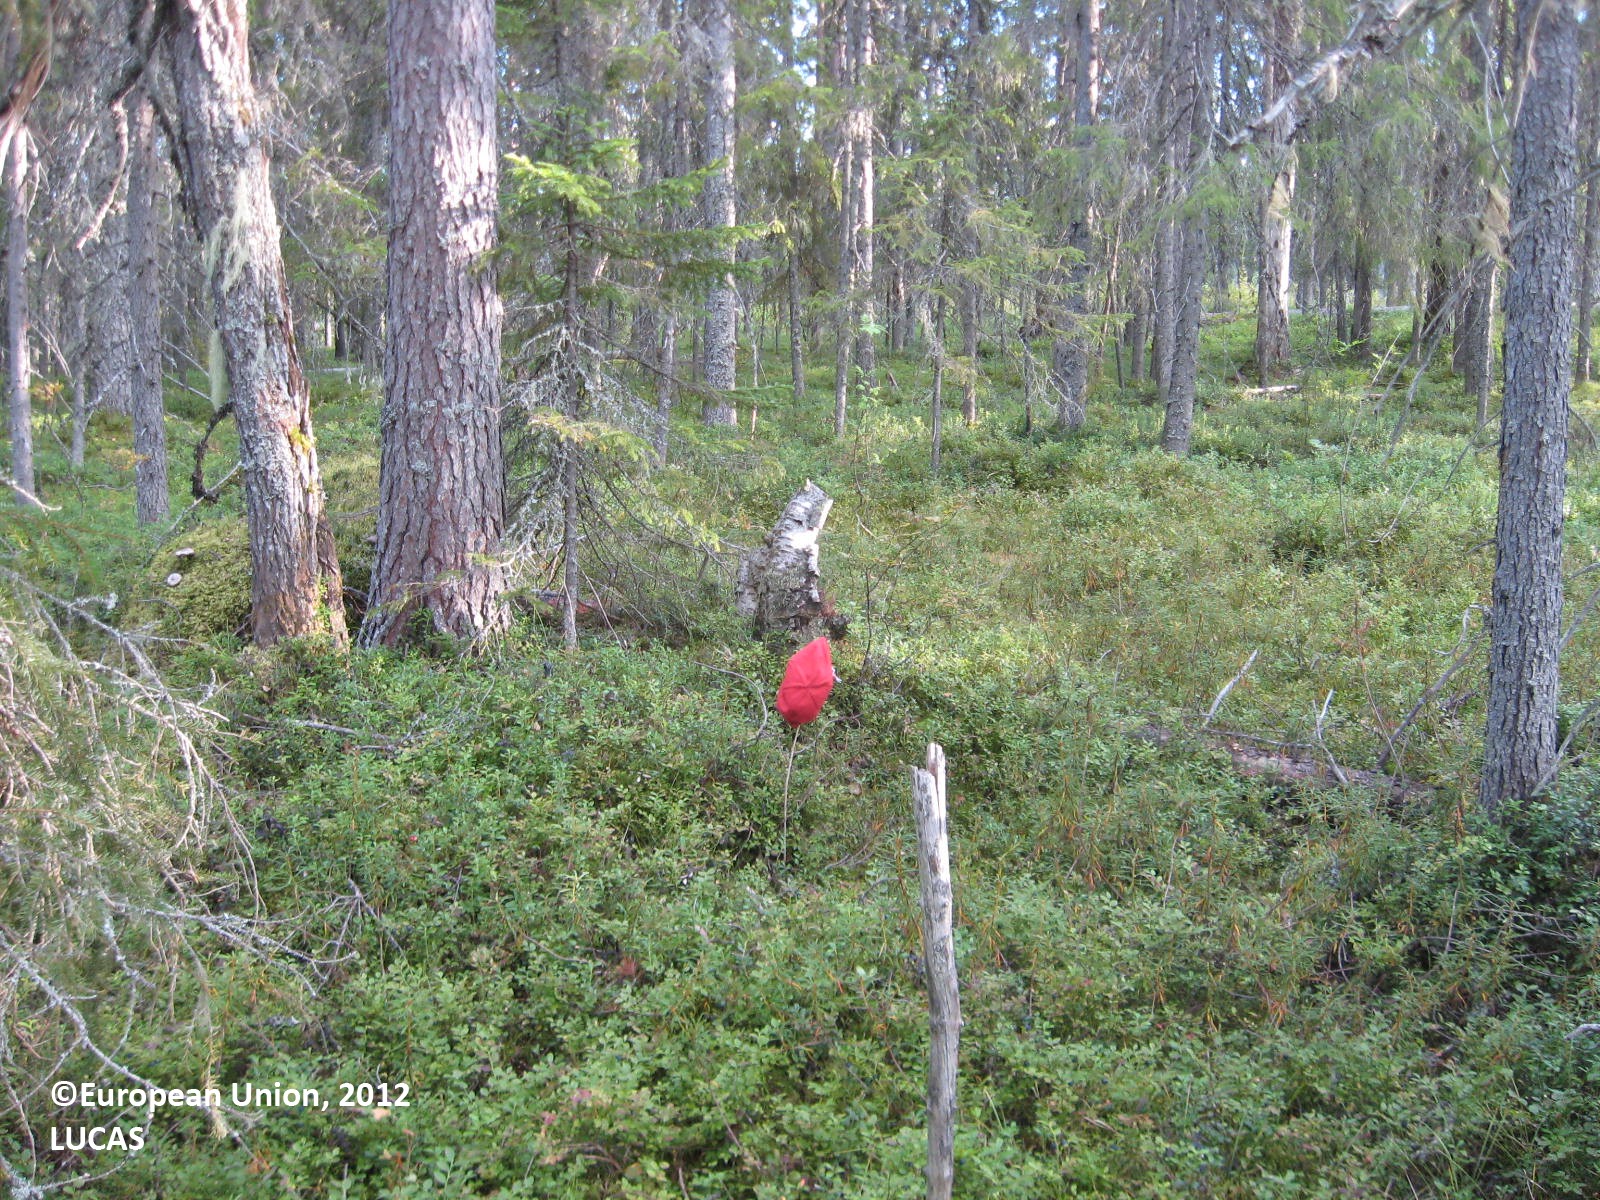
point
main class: Woodland
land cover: Spruce dominated coniferous woodland
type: boreal forest
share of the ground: > 75 %
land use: Forestry
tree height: > 5 m
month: August
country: FI
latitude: 63.9083
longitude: 29.8616
